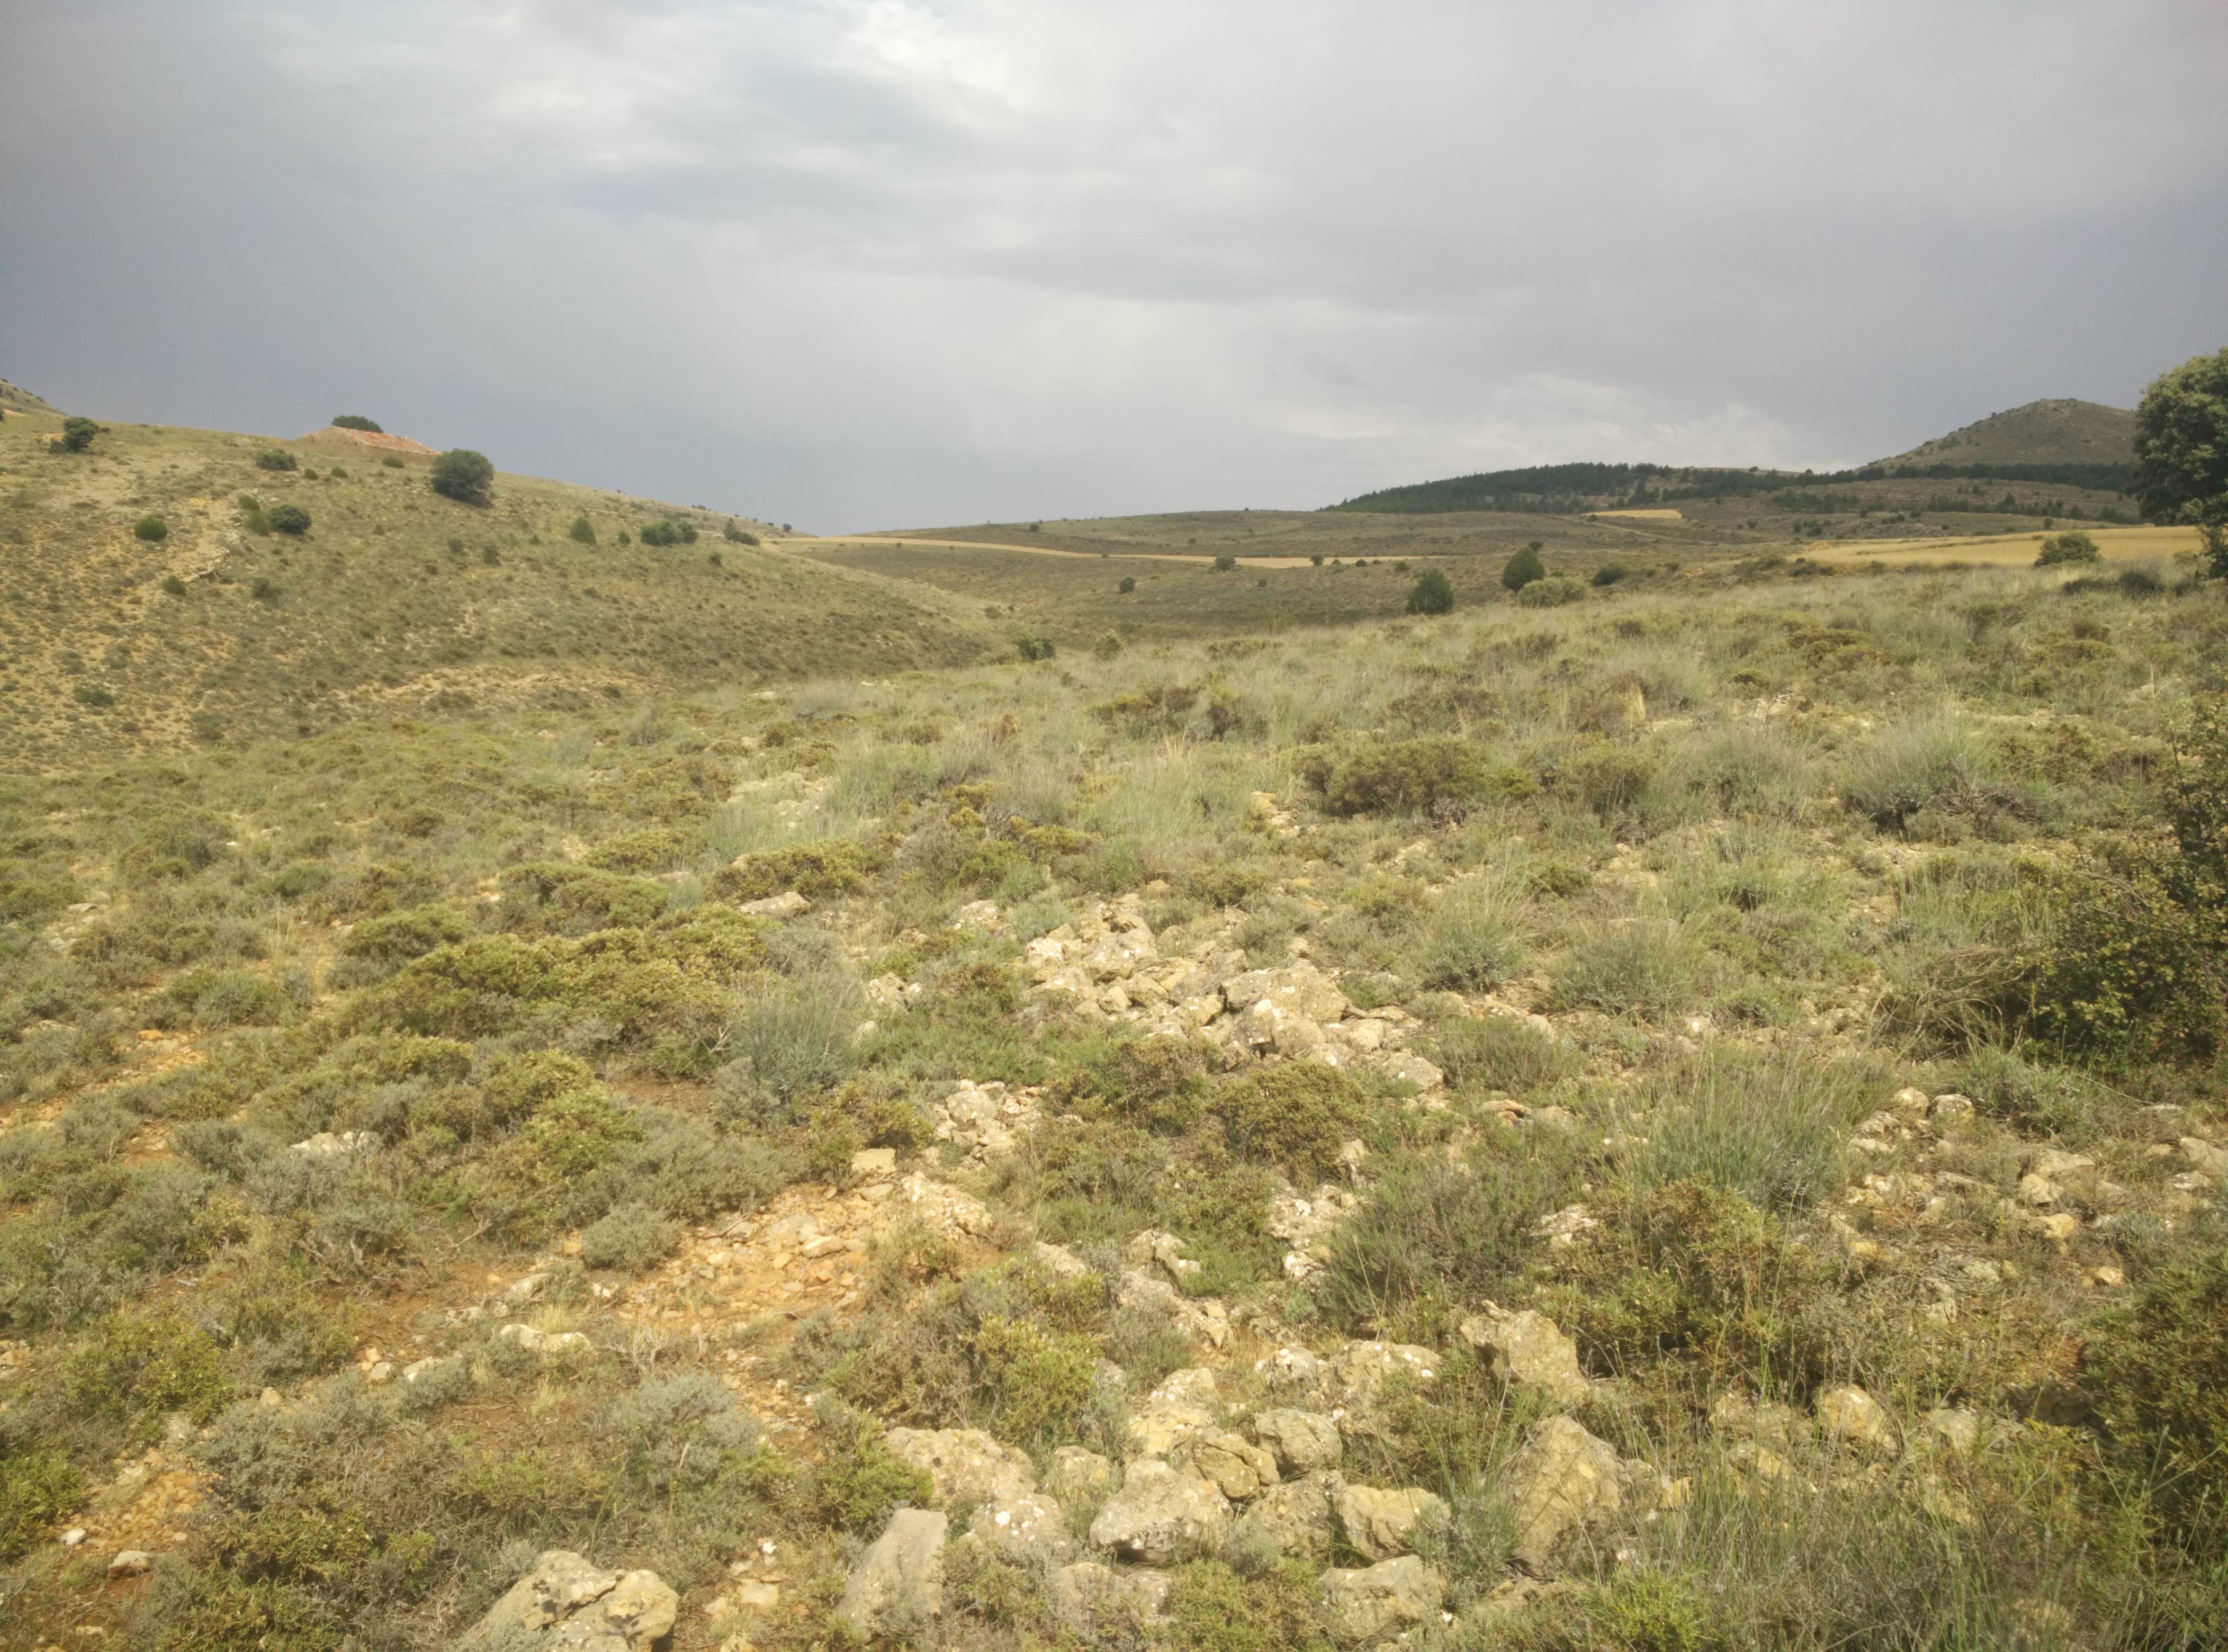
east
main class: Shrubland
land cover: Shrubland without tree cover
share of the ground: > 75 %
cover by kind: shrubs 80 %, unconsolidated bare surface 20 %
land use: Semi-natural and natural areas not in use
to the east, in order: Shrubland without tree cover; Rivers and streams; Shrubland without tree cover
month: July
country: ES
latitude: 41.0602
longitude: -1.8641
